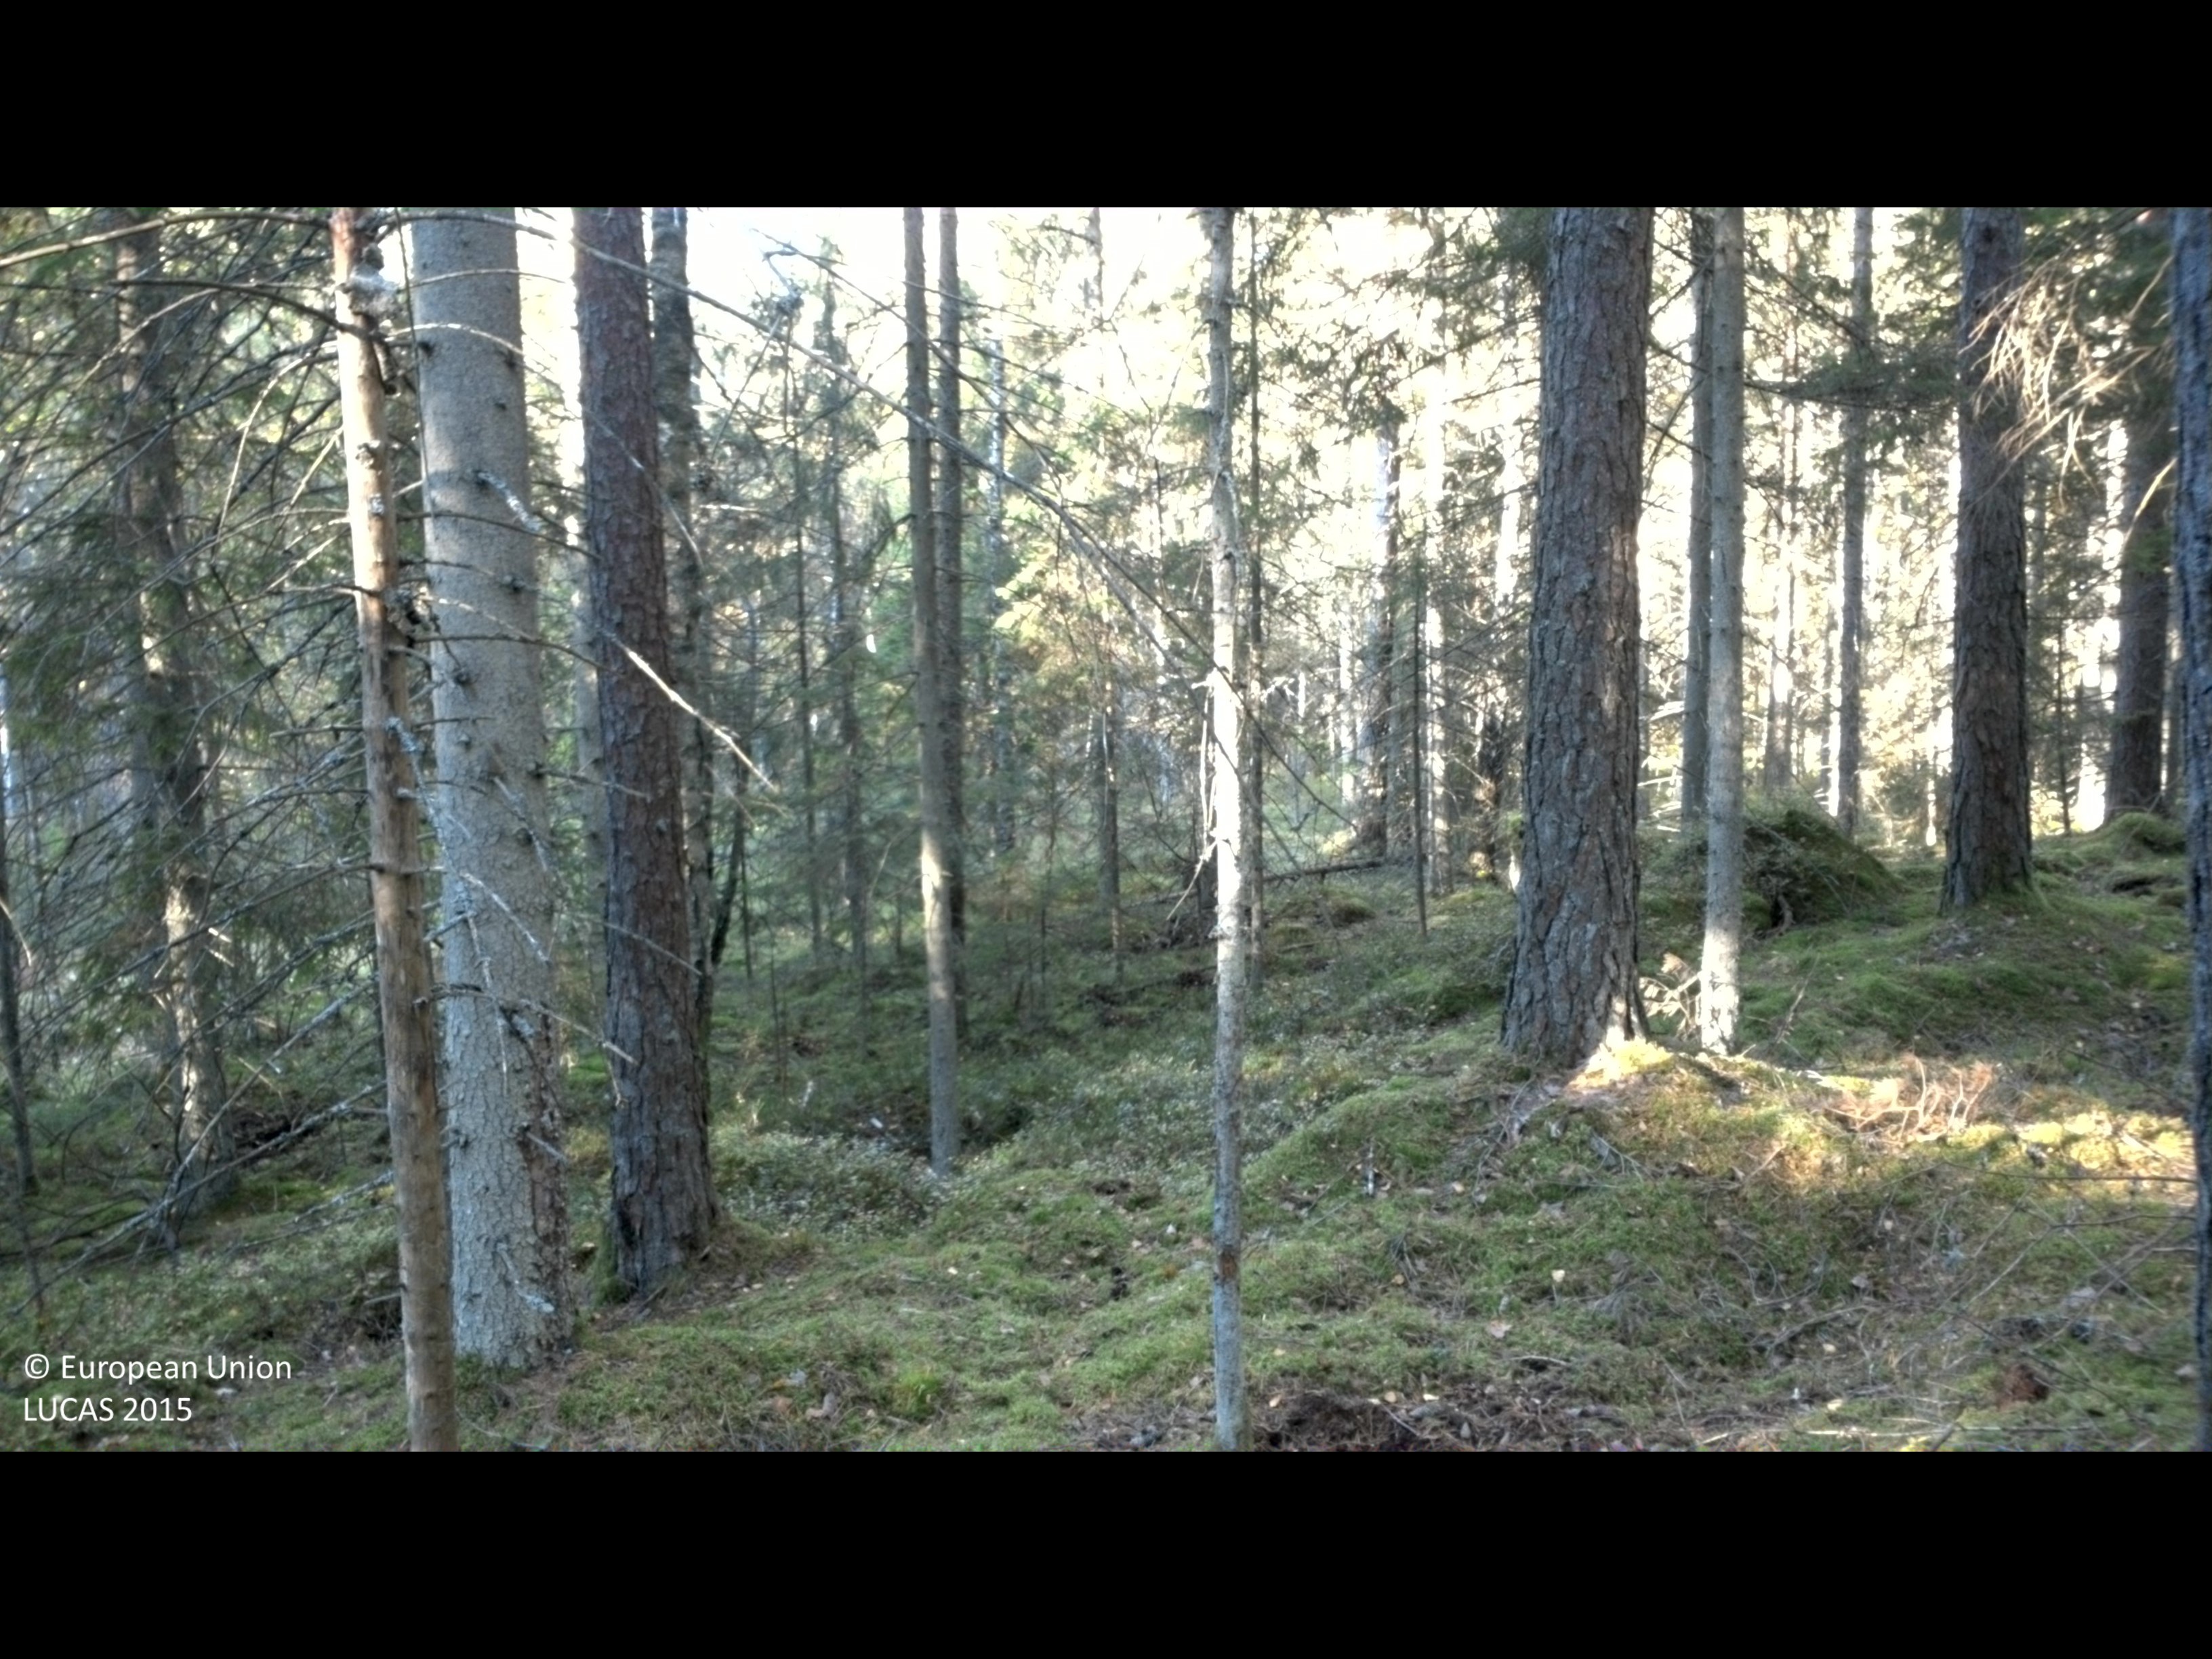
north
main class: Woodland
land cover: Spruce dominated coniferous woodland
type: boreal forest
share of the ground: > 75 %
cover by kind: coniferous forest trees 75 %, lichens and mosses 15 %, shrubs 10 %
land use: Forestry
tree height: > 5 m
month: September
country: SE
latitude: 56.3171
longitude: 15.1885
